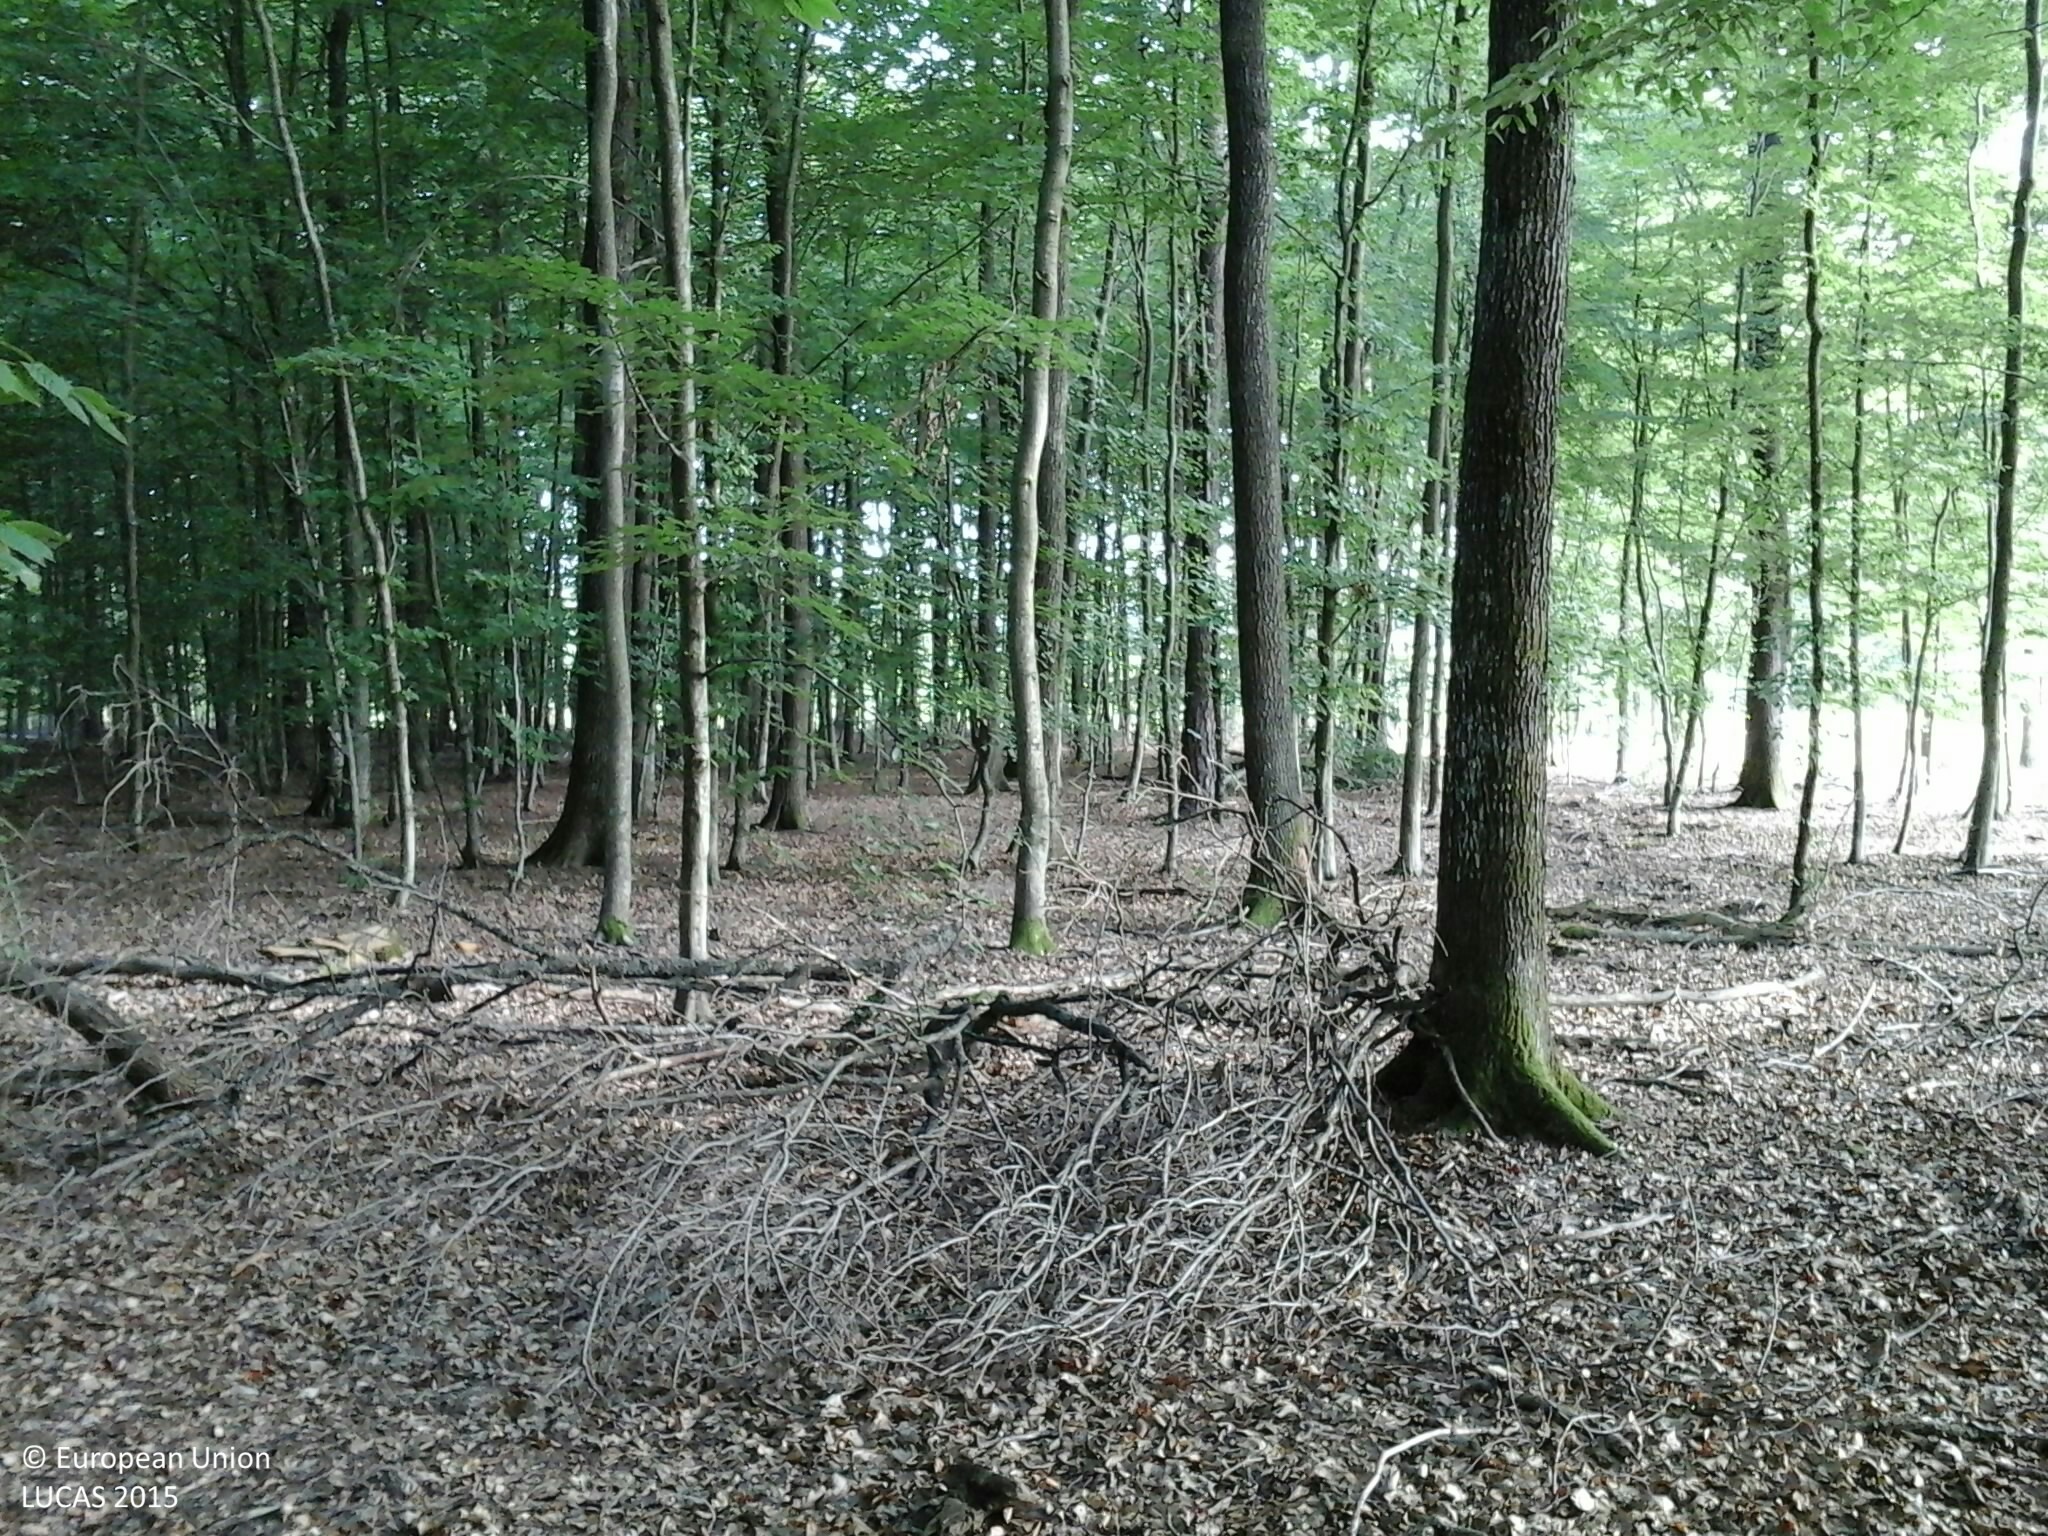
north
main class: Woodland
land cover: Broadleaved woodland
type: mesophytic deciduous forest
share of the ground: > 75 %
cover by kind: broadleaved forest trees 70 %, coniferous forest trees 20 %, shrubs 5 %, herbaceous plants 5 %
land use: Forestry
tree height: > 5 m
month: July
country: HU
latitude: 46.8794
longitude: 16.4447
